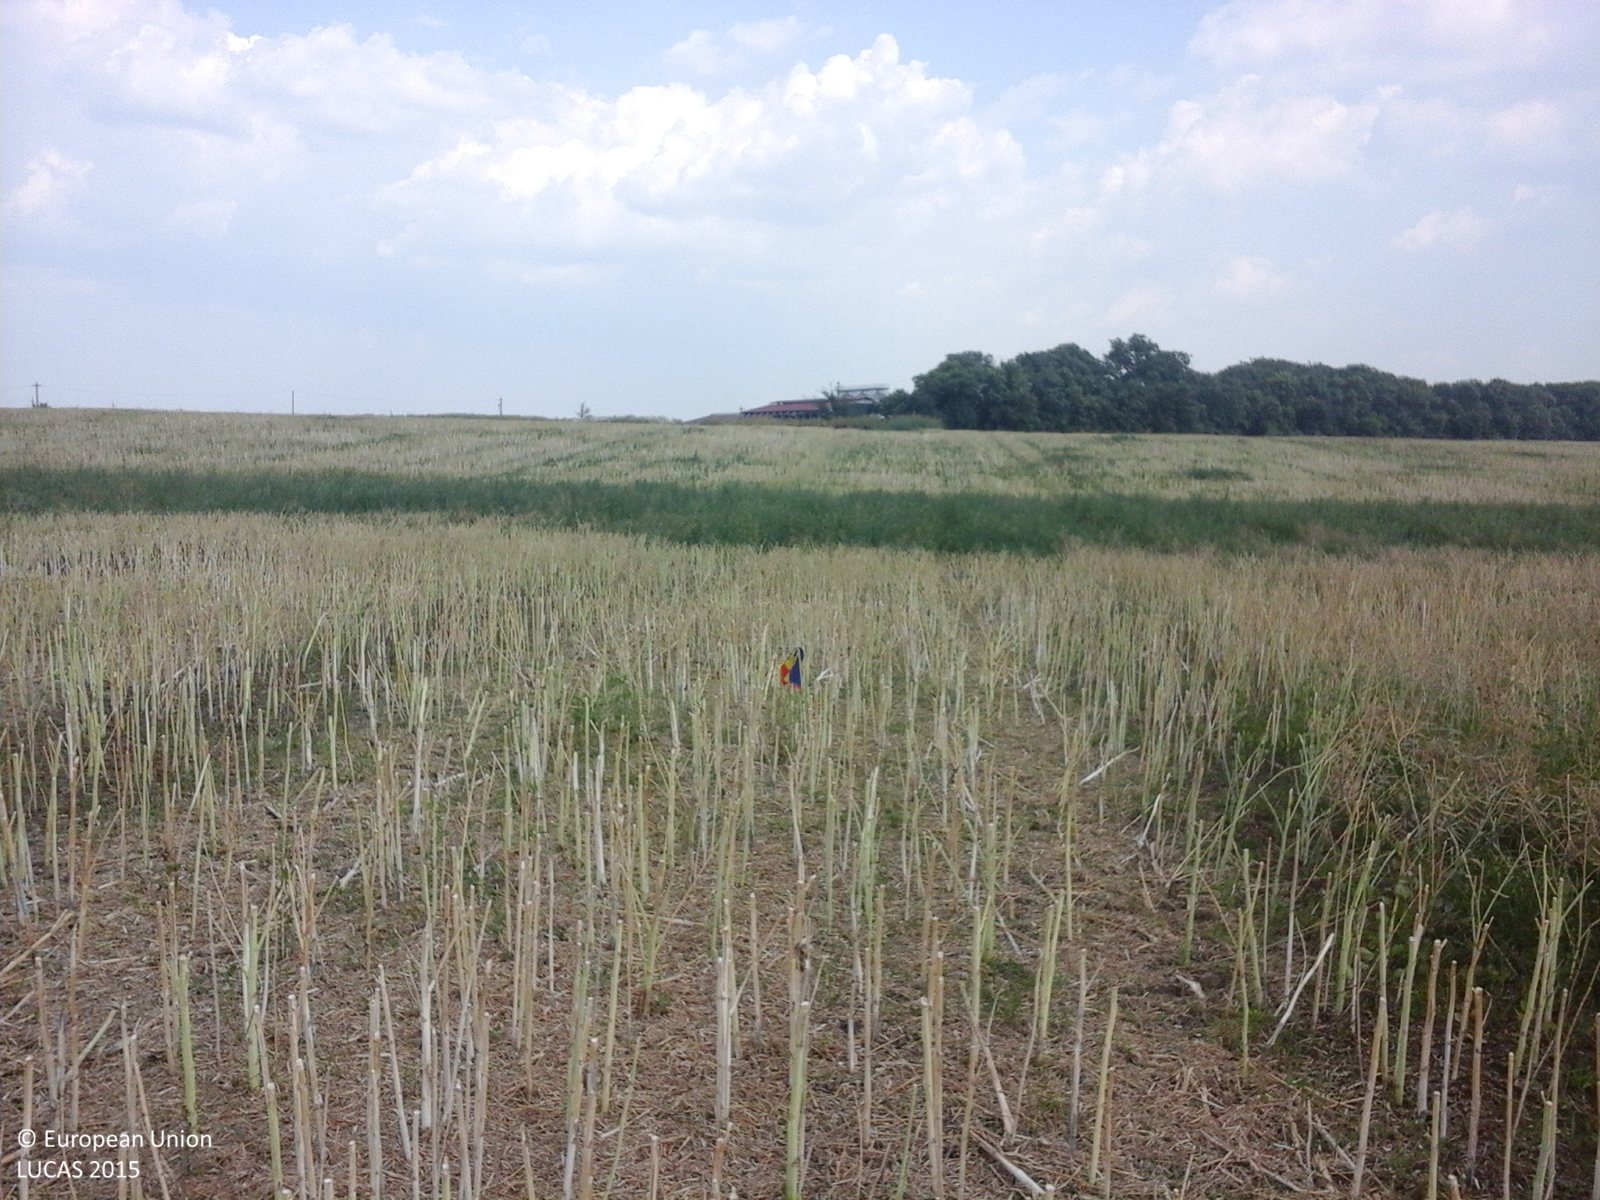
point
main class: Cropland
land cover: Rape and turnip rape
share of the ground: < 10 %
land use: Agriculture (excluding fallow land and kitchen gardens)
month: July
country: RO
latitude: 43.8801
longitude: 24.8452
